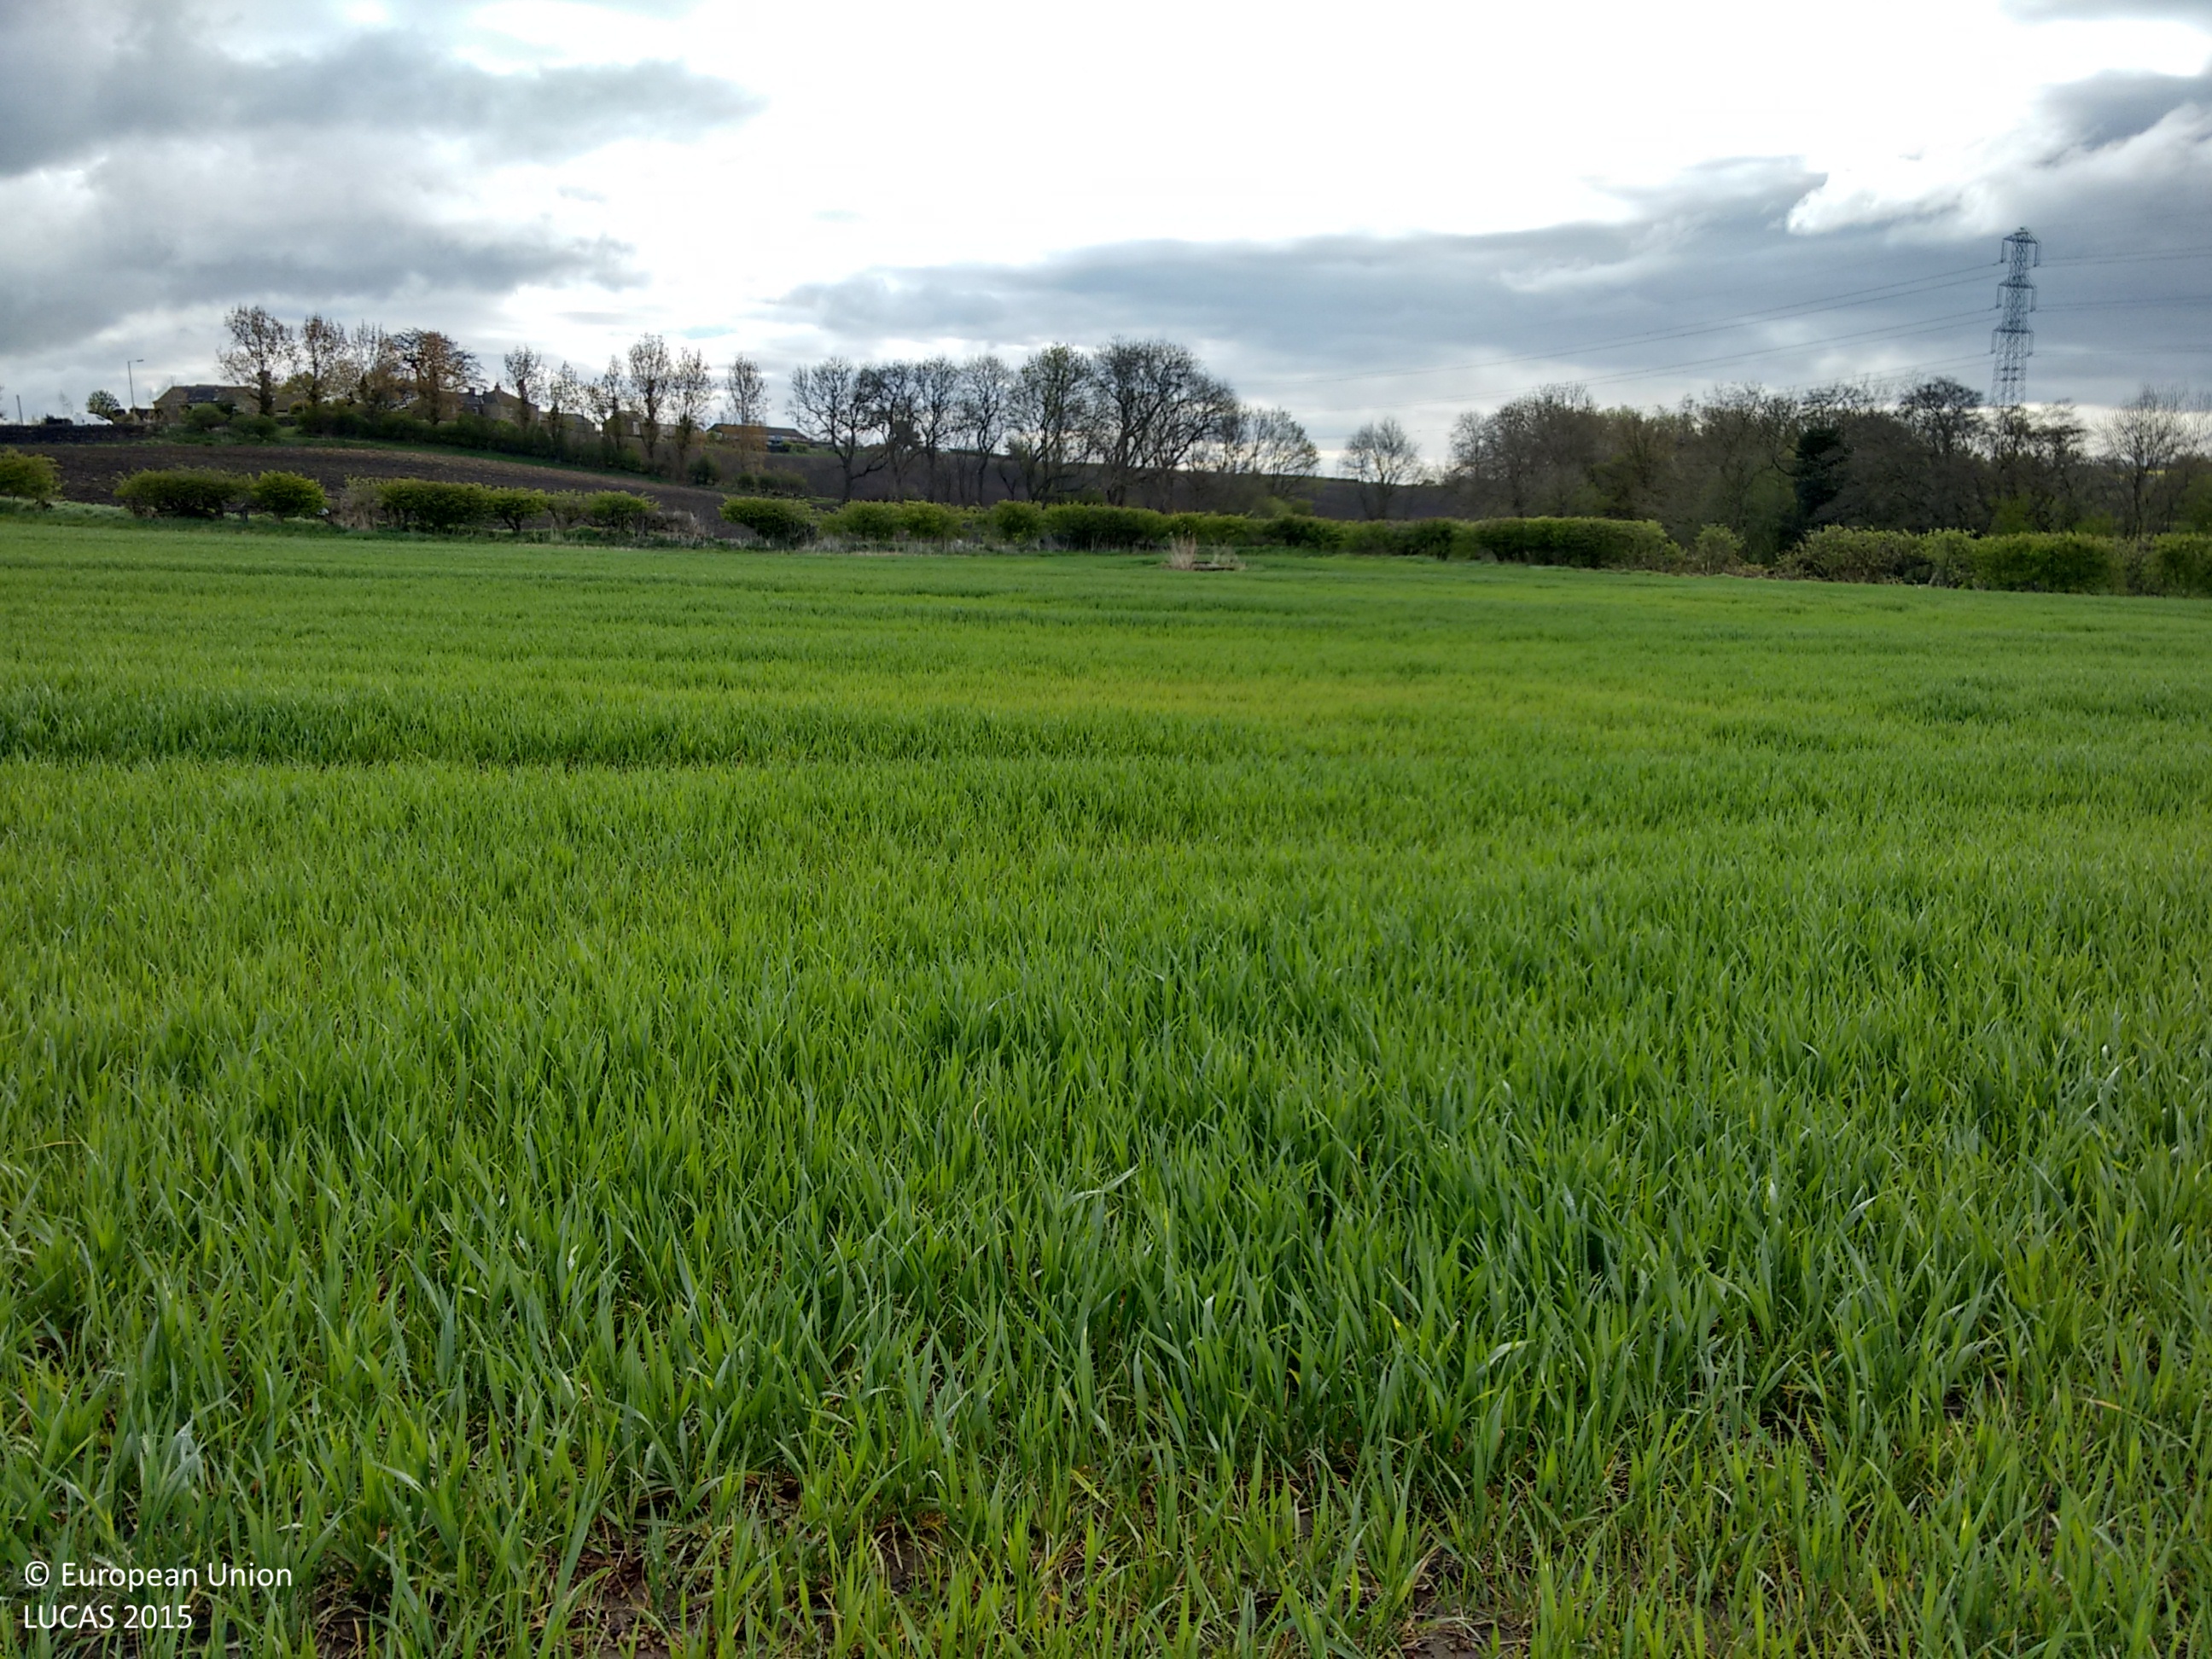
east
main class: Cropland
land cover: Common wheat
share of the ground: > 75 %
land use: Agriculture (excluding fallow land and kitchen gardens)
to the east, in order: Common wheat; Abandoned hedges; Other bare soil; Grass margins; Broadleaved woodland; Tracks; Broadleaved woodland; Other bare soil
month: April
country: GB
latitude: 53.6603
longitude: -1.5974
